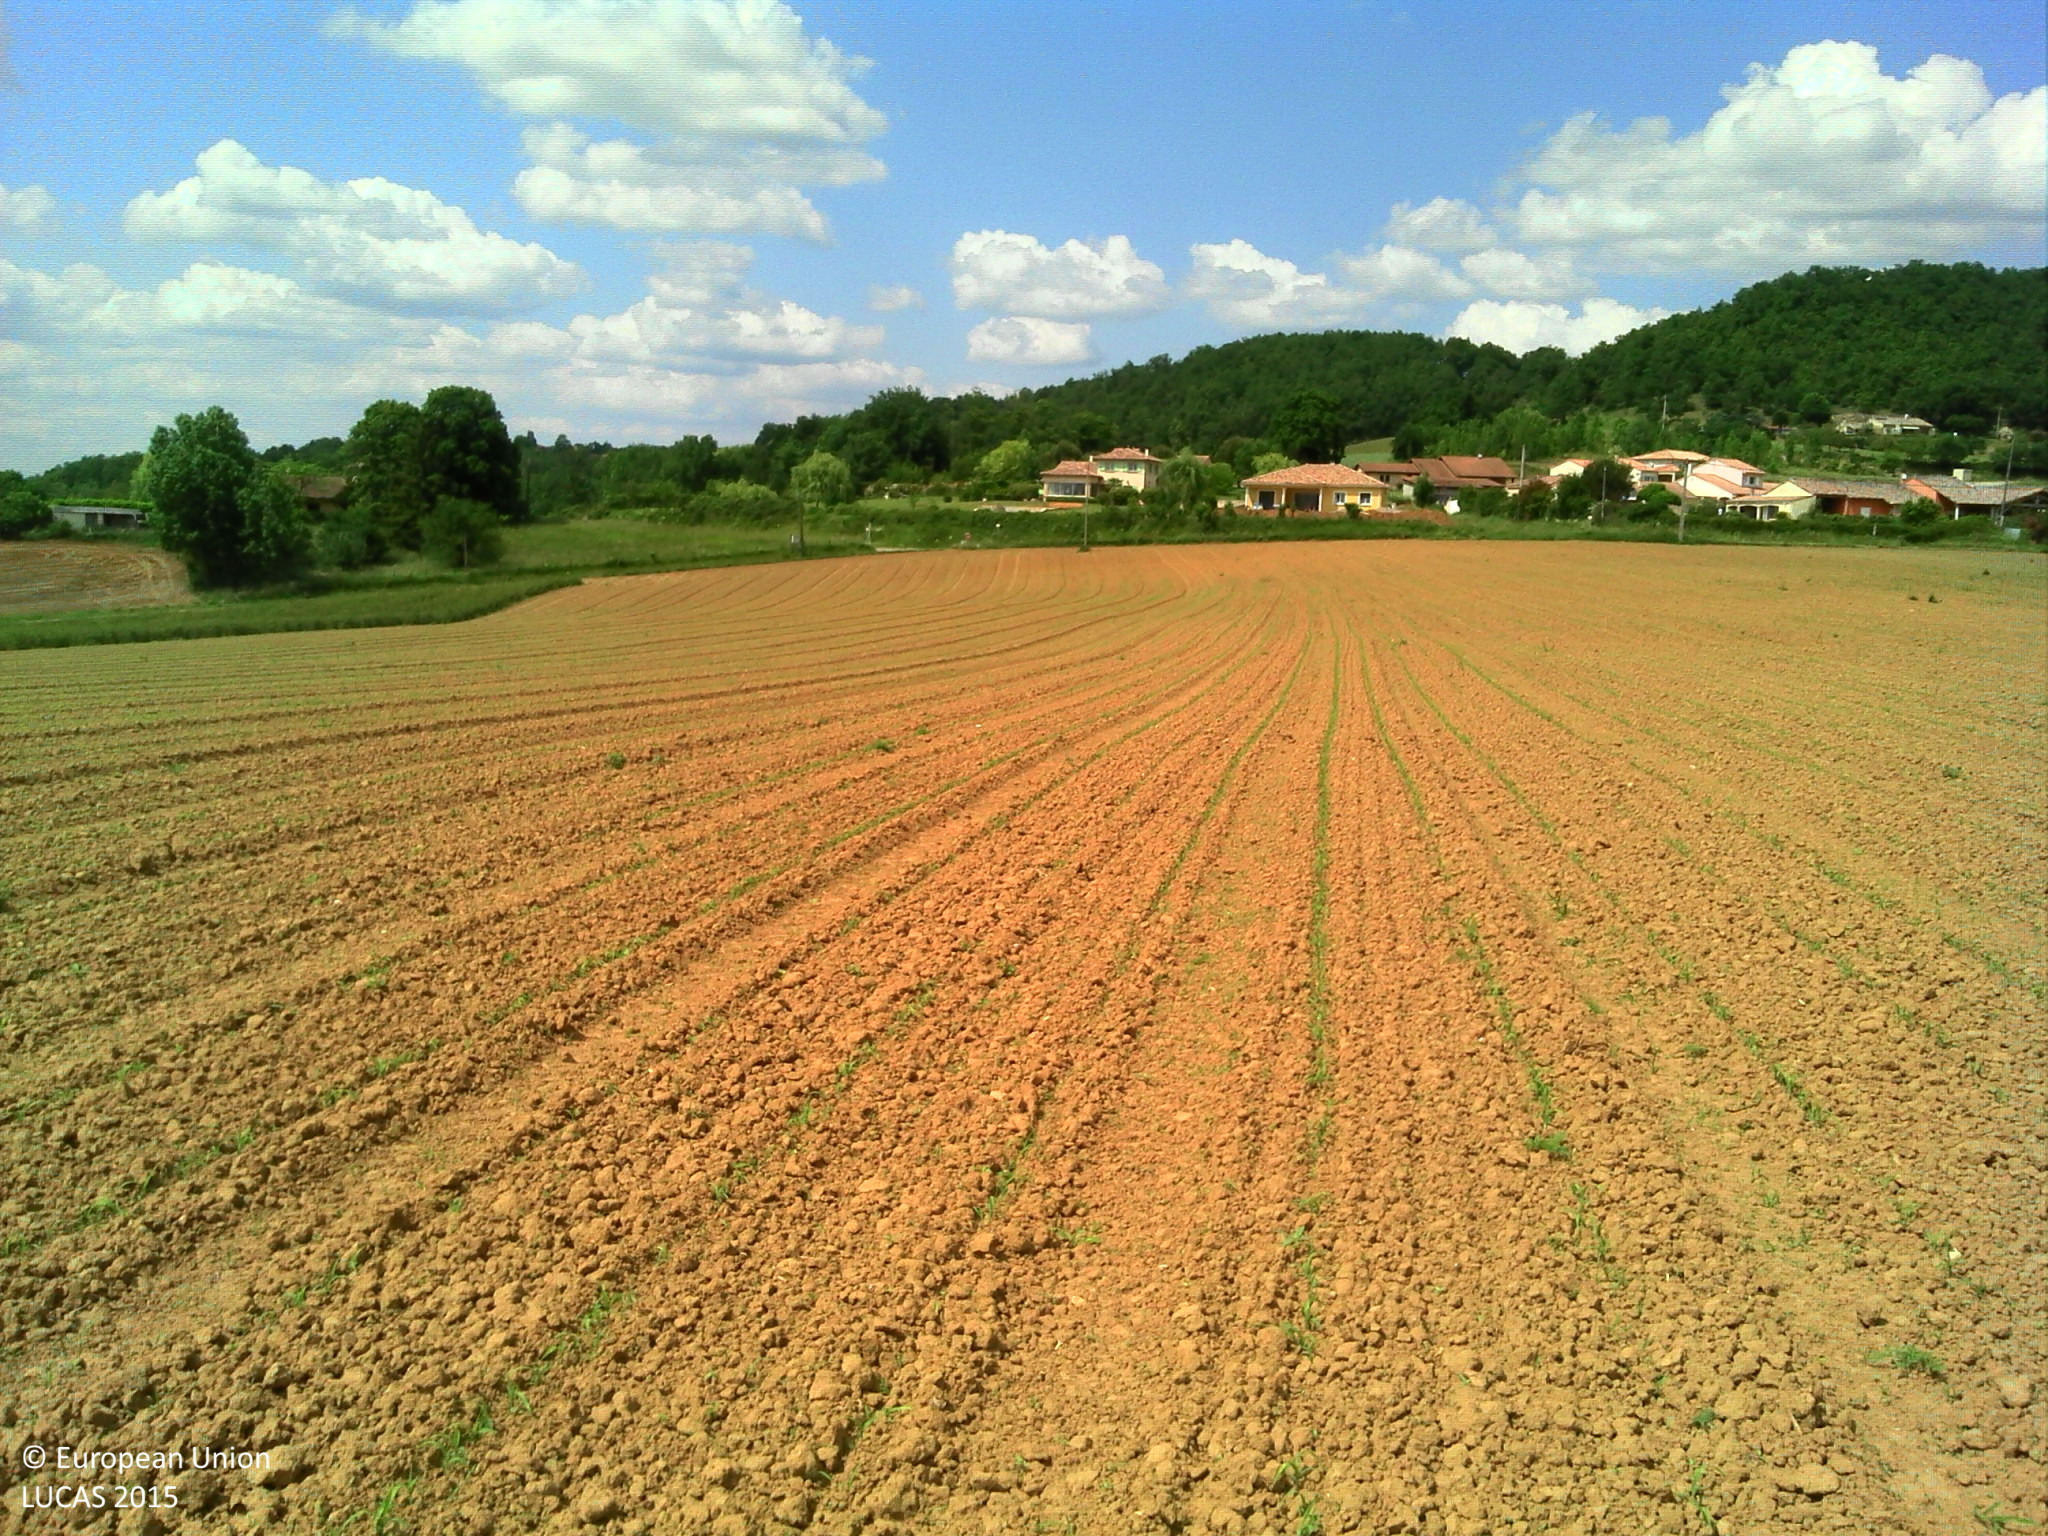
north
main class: Cropland
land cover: Maize
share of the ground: < 10 %
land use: Agriculture (excluding fallow land and kitchen gardens)
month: May
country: FR
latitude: 45.0136
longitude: 5.1458
